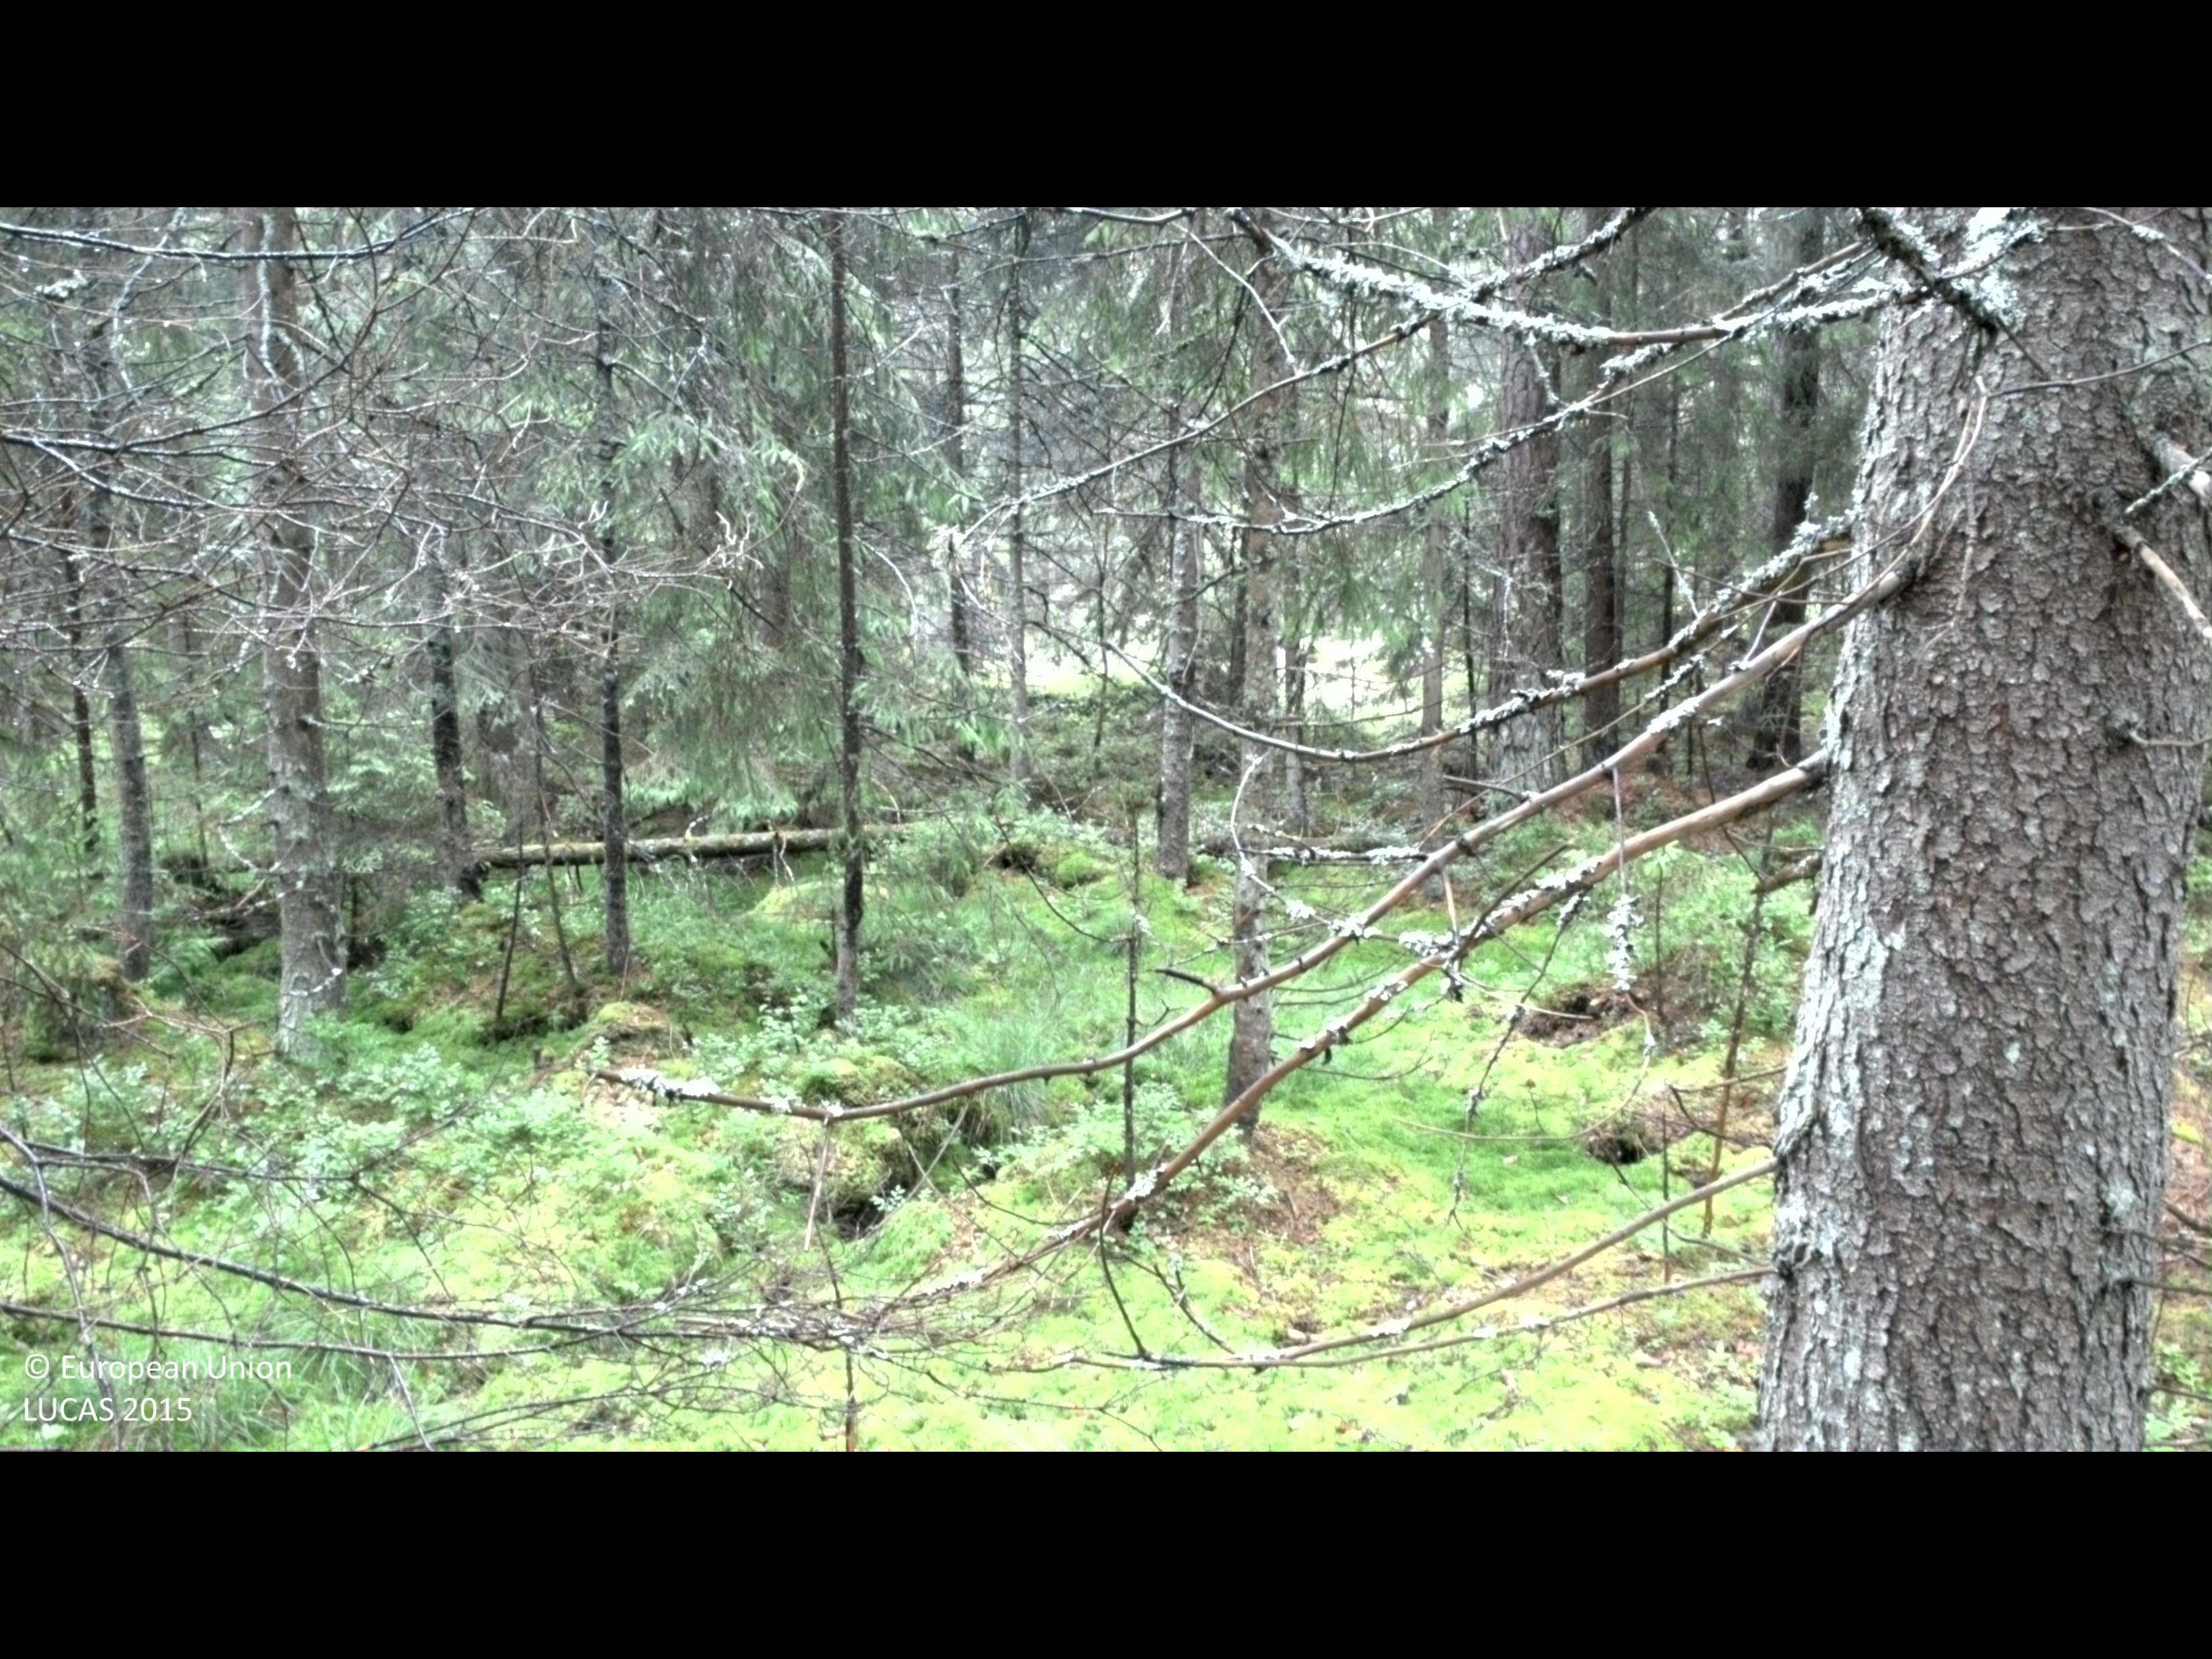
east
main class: Woodland
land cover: Spruce dominated coniferous woodland
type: boreal forest
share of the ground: 50 - 75 %
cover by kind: coniferous forest trees 75 %, shrubs 15 %, lichens and mosses 10 %
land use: Forestry
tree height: > 5 m
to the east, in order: Spruce dominated coniferous woodland; Lichens and moss; Spruce dominated coniferous woodland; Groves; Rivers and streams; Spontaneously vegetated surfaces; Ditches and canals; Other mixed woodland; Rocks and stones; Pine dominated mixed woodland; Other leguminous and mixtures for fodder
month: June
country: SE
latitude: 58.0514
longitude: 16.3510
